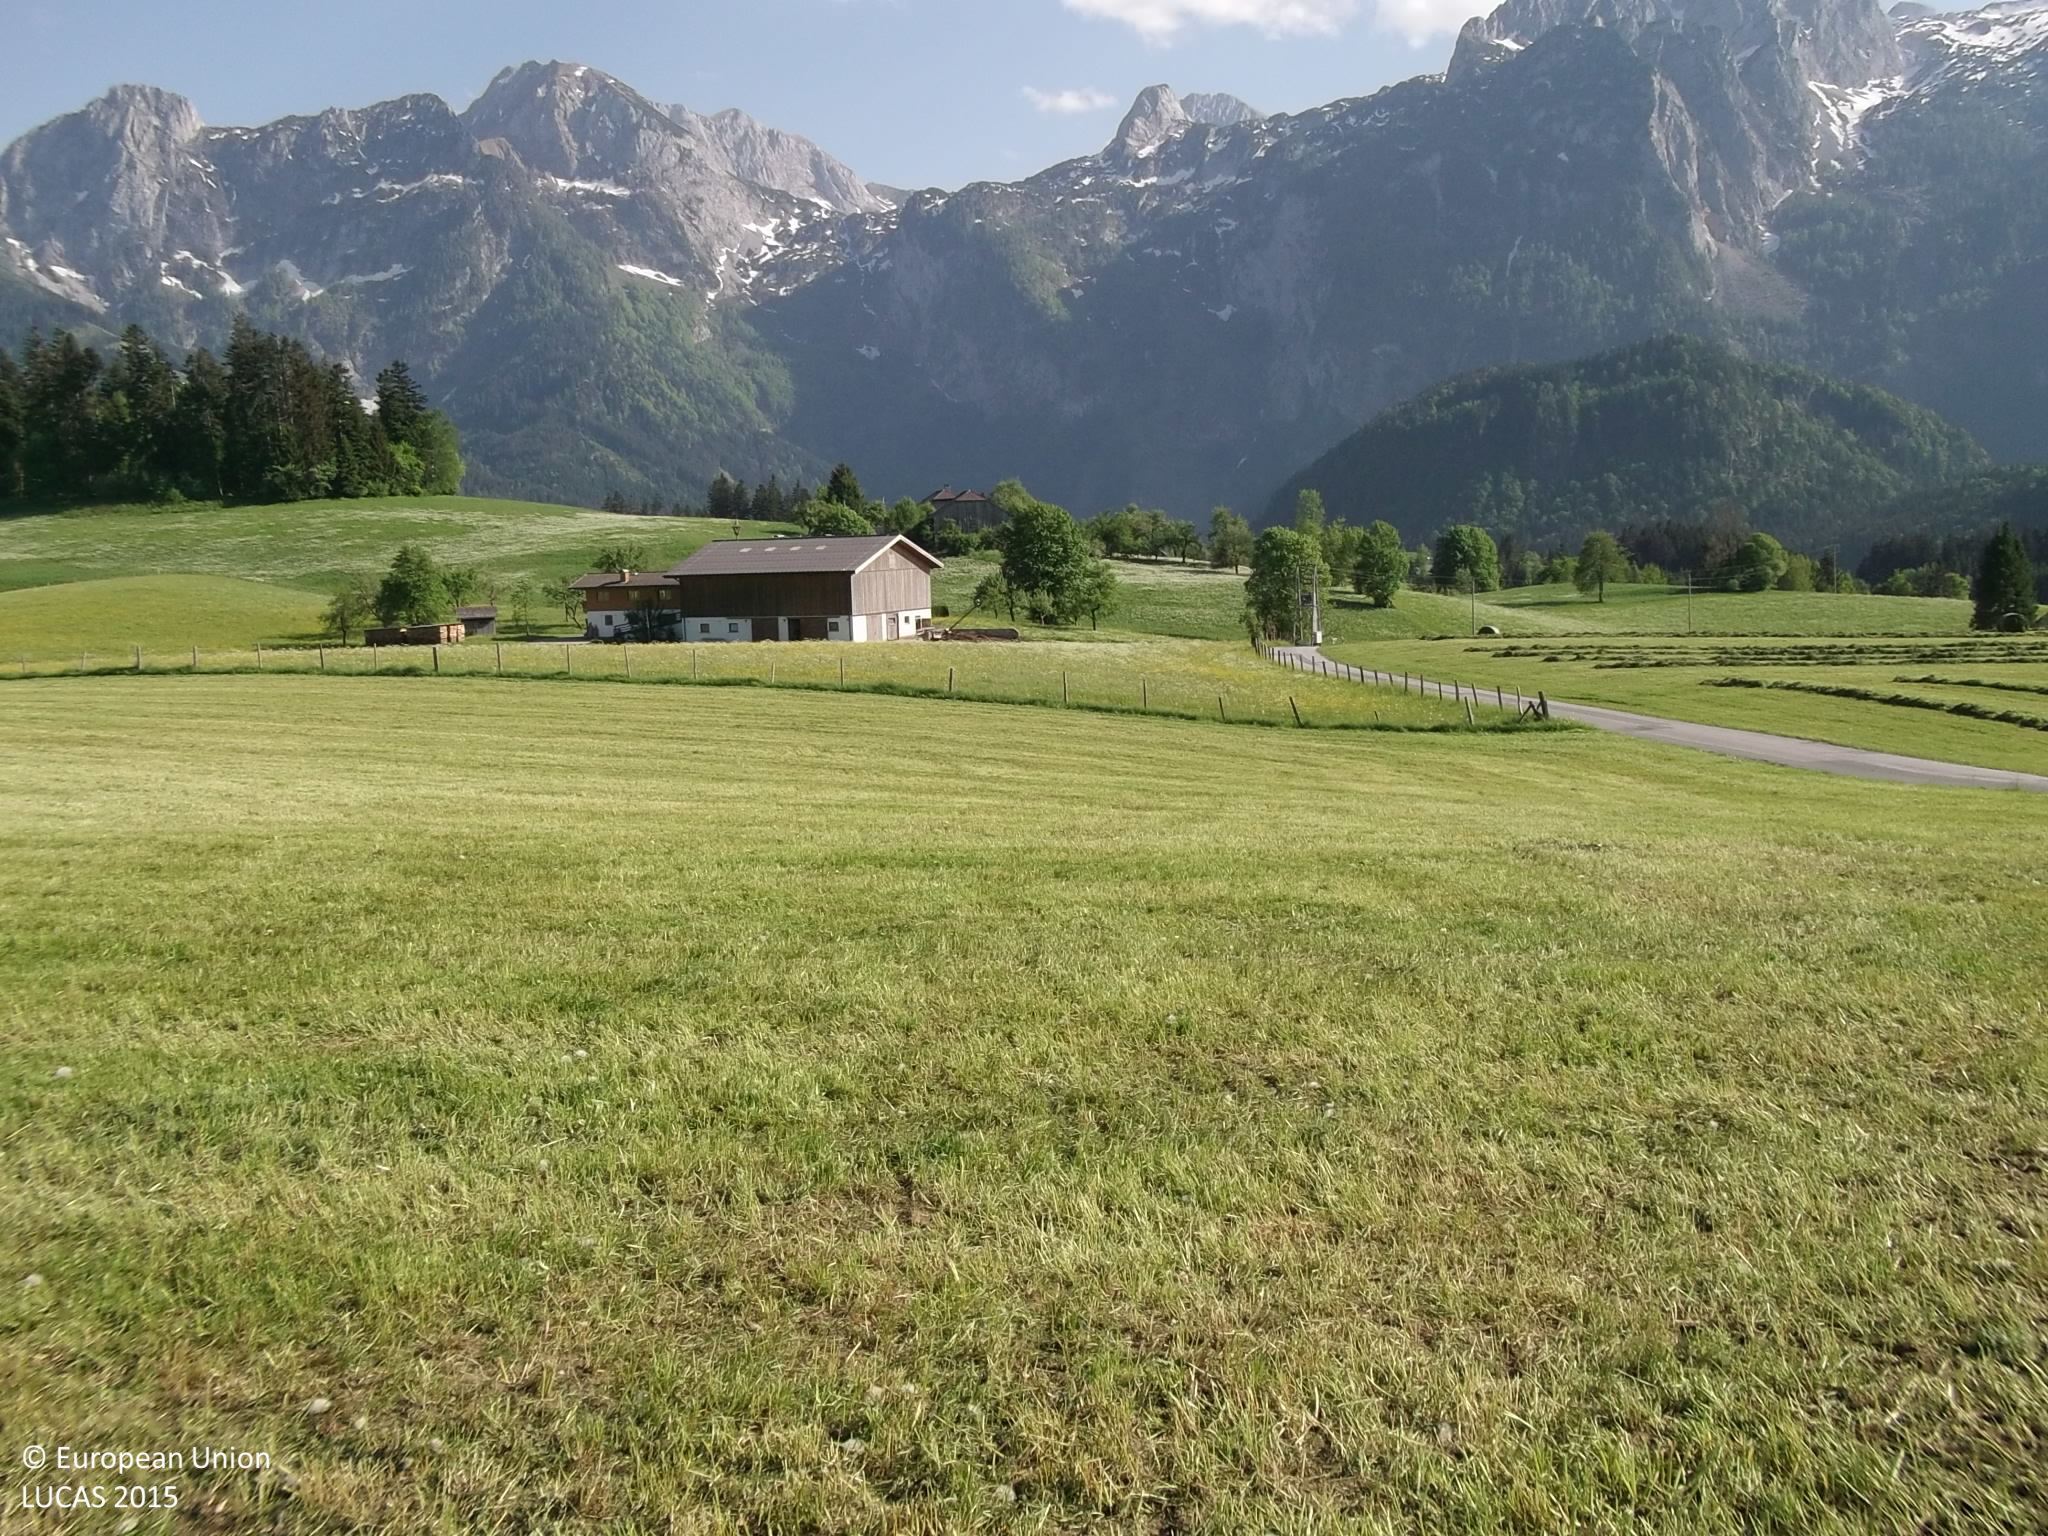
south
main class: Grassland
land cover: Grassland without tree/shrub cover
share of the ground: > 75 %
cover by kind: herbaceous plants 100 %
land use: Agriculture (excluding fallow land and kitchen gardens)
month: May
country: AT
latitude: 47.5787
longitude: 13.3355
